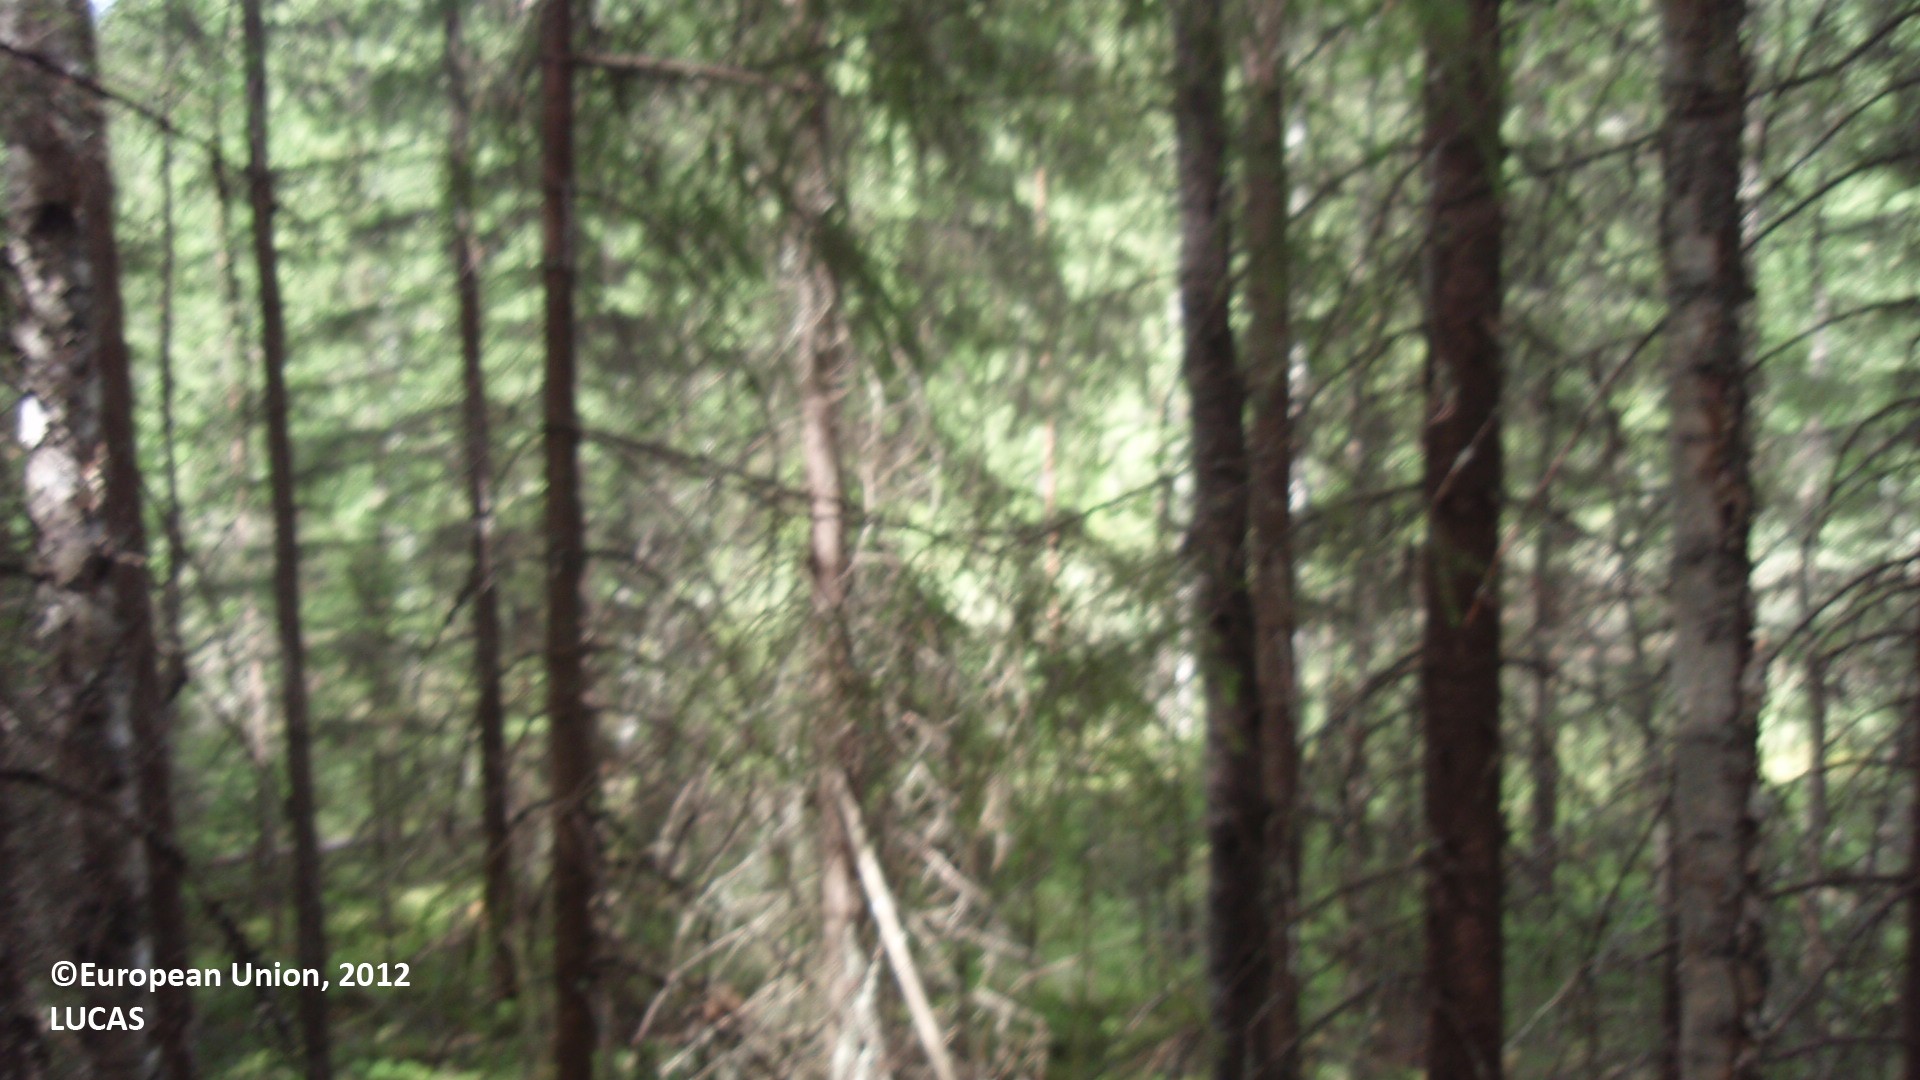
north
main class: Woodland
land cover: Spruce dominated mixed woodland
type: boreal forest
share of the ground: 25 - 50 %
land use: Forestry
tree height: > 5 m
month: June
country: FI
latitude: 61.3938
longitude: 26.9948
